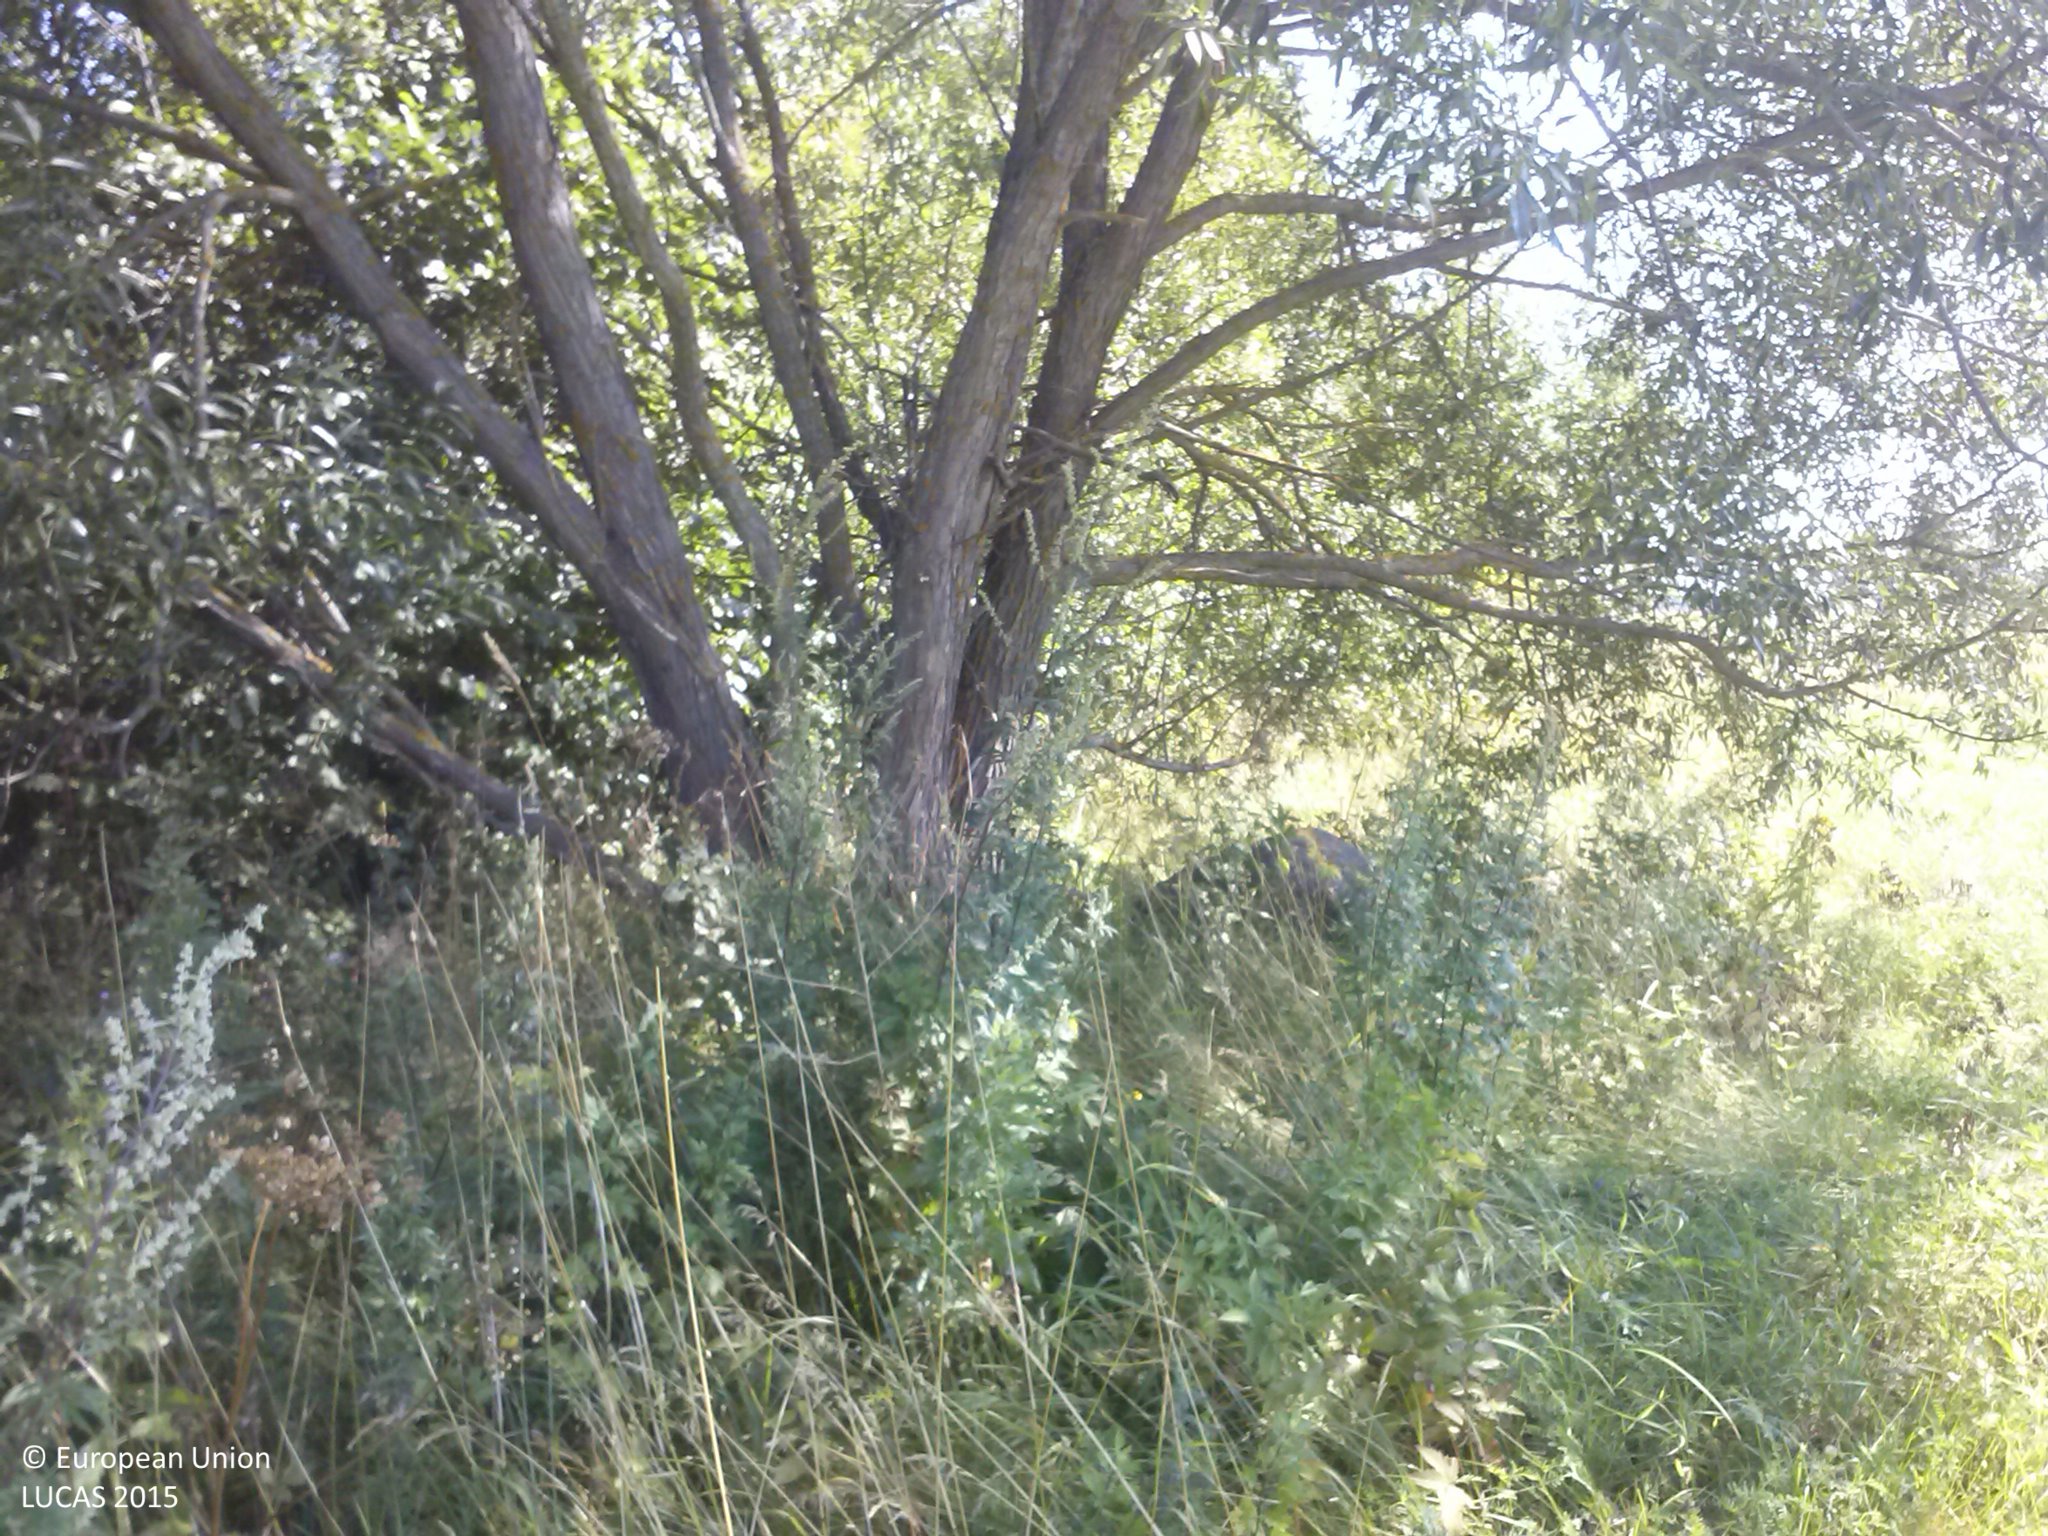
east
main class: Grassland
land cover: Grassland without tree/shrub cover
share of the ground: > 75 %
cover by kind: herbaceous plants 100 %
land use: Agriculture (excluding fallow land and kitchen gardens)
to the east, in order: Grassland without tree/shrub cover; Fences; Tracks; Grass margins; Broadleaved woodland; Ditches and canals; Broadleaved woodland; Grassland without tree/shrub cover
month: August
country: LV
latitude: 56.7259
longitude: 27.7552
